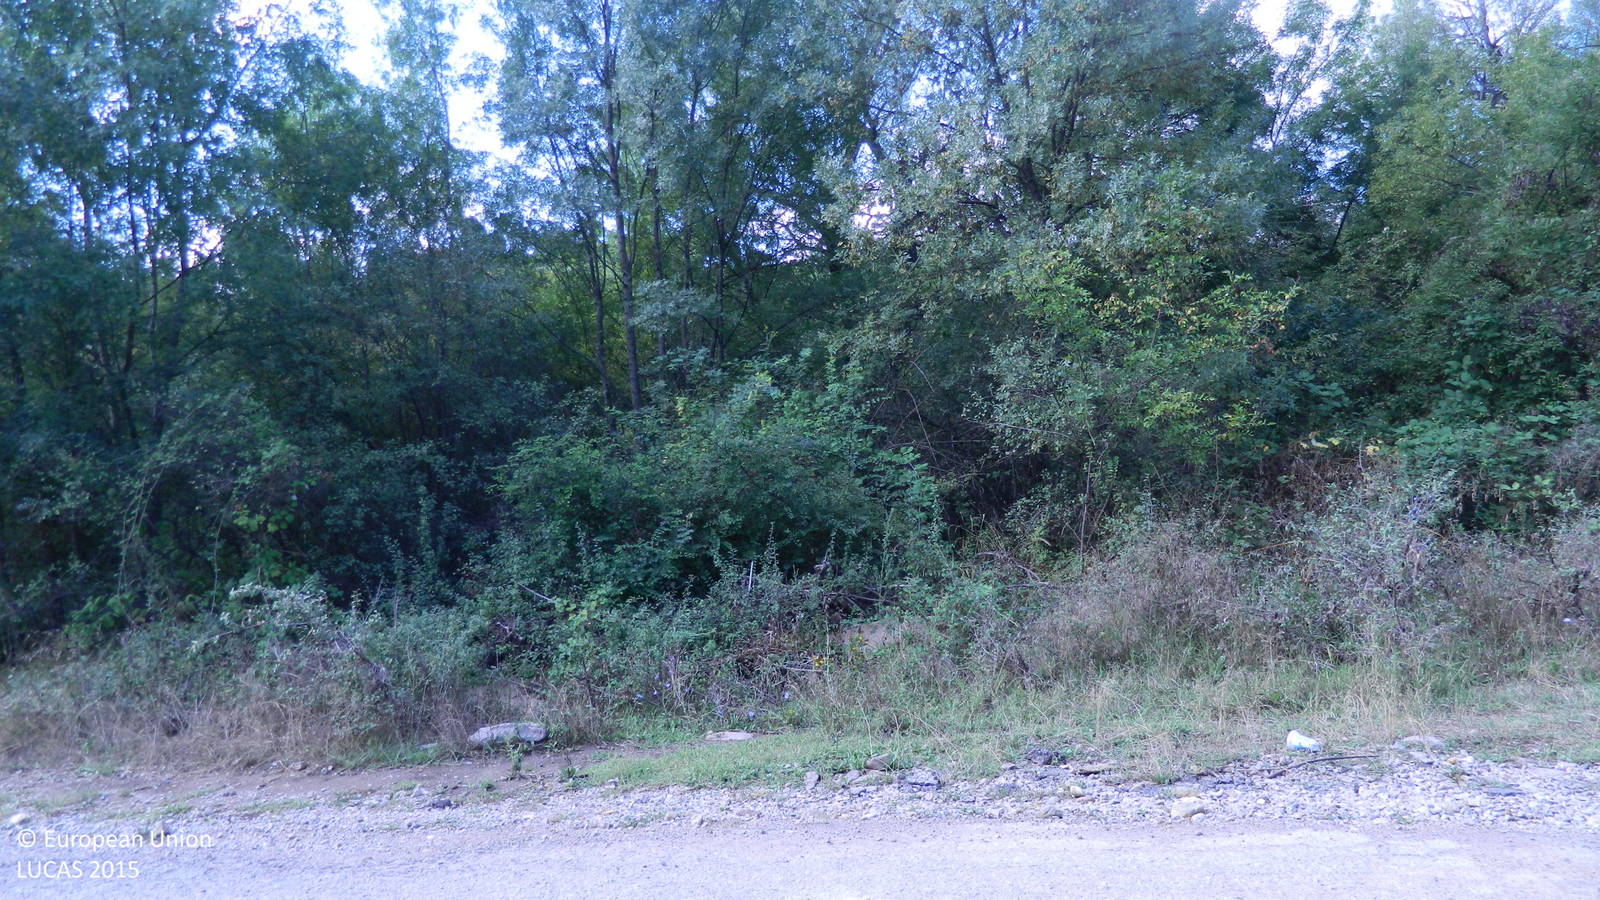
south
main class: Woodland
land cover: Broadleaved woodland
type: mesophytic deciduous forest
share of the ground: > 75 %
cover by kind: broadleaved forest trees 90 %, shrubs 5 %, herbaceous plants 5 %
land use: Forestry
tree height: > 5 m
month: August
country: BG
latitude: 41.6881
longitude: 25.8663
